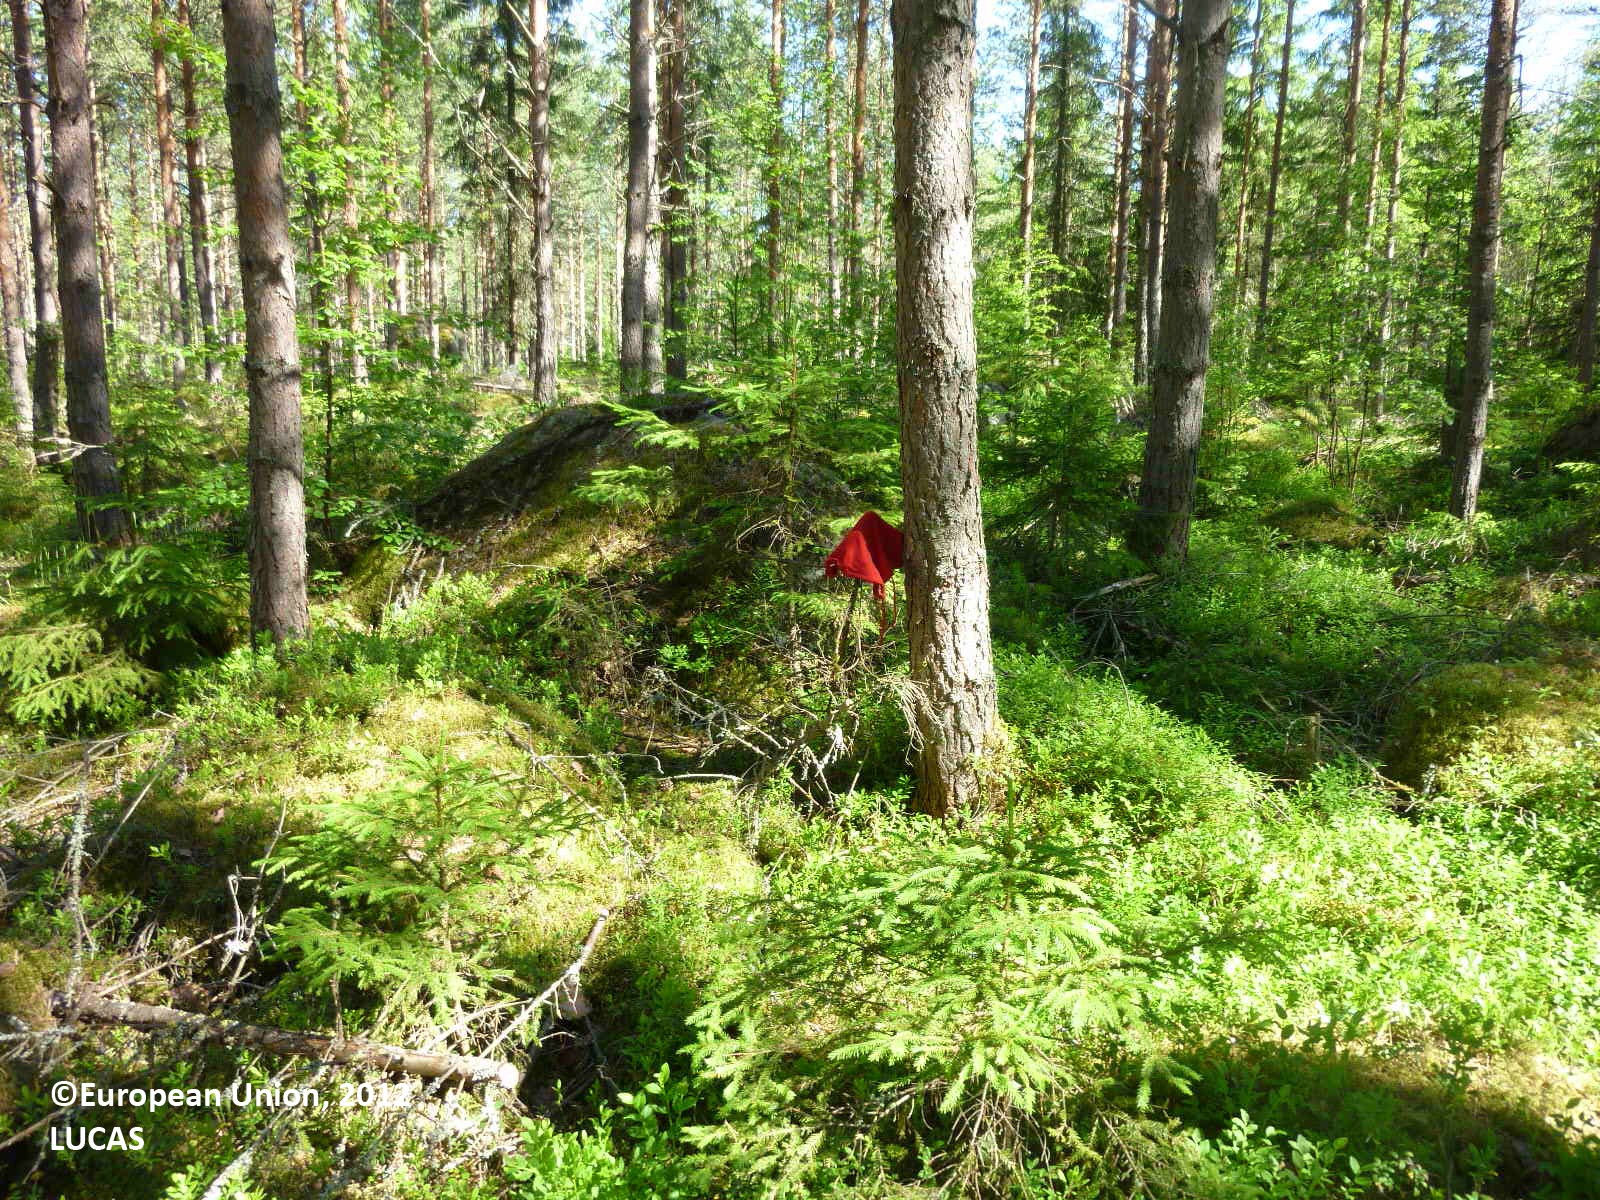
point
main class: Woodland
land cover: Pine dominated coniferous woodland
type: boreal forest
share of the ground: 50 - 75 %
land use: Forestry
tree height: > 5 m
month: June
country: FI
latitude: 61.6250
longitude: 22.1485
